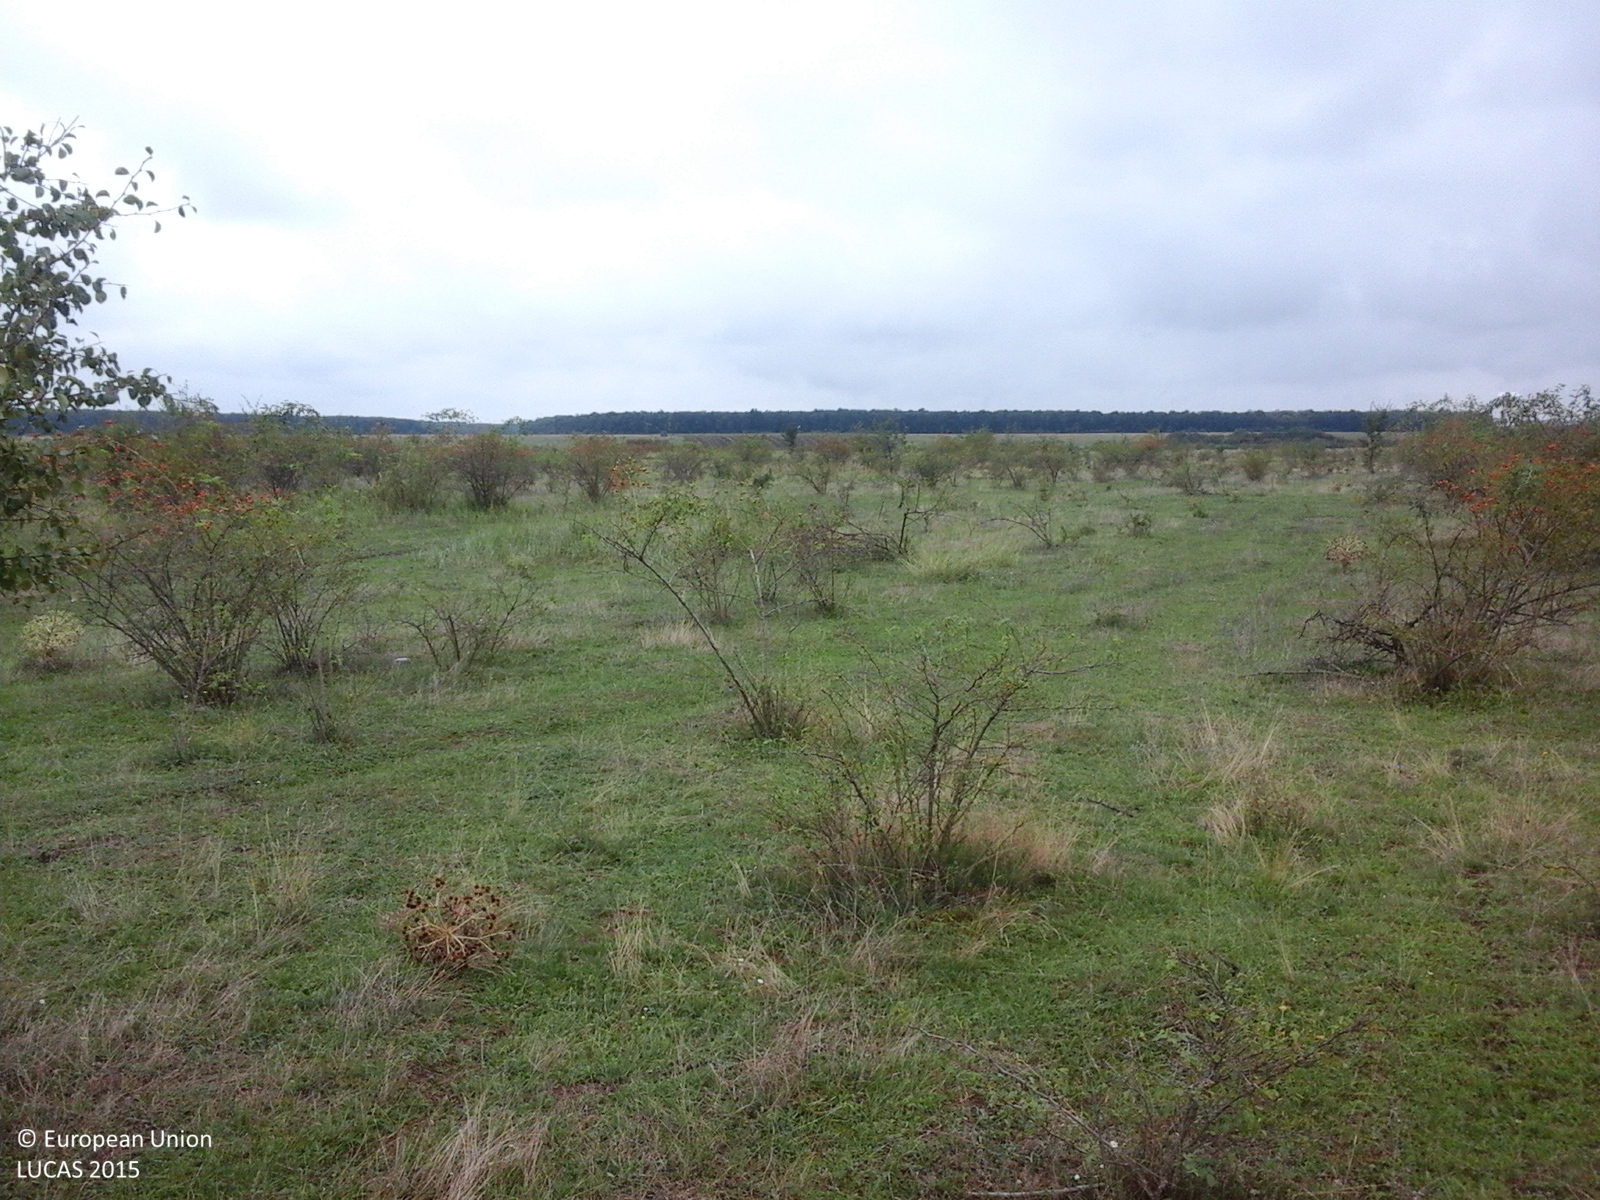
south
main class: Artificial land
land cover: Non built-up area features
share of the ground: 50 - 75 %
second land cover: Grassland without tree/shrub cover
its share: > 75 %
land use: Energy production
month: September
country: RO
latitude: 46.9298
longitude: 21.8254
